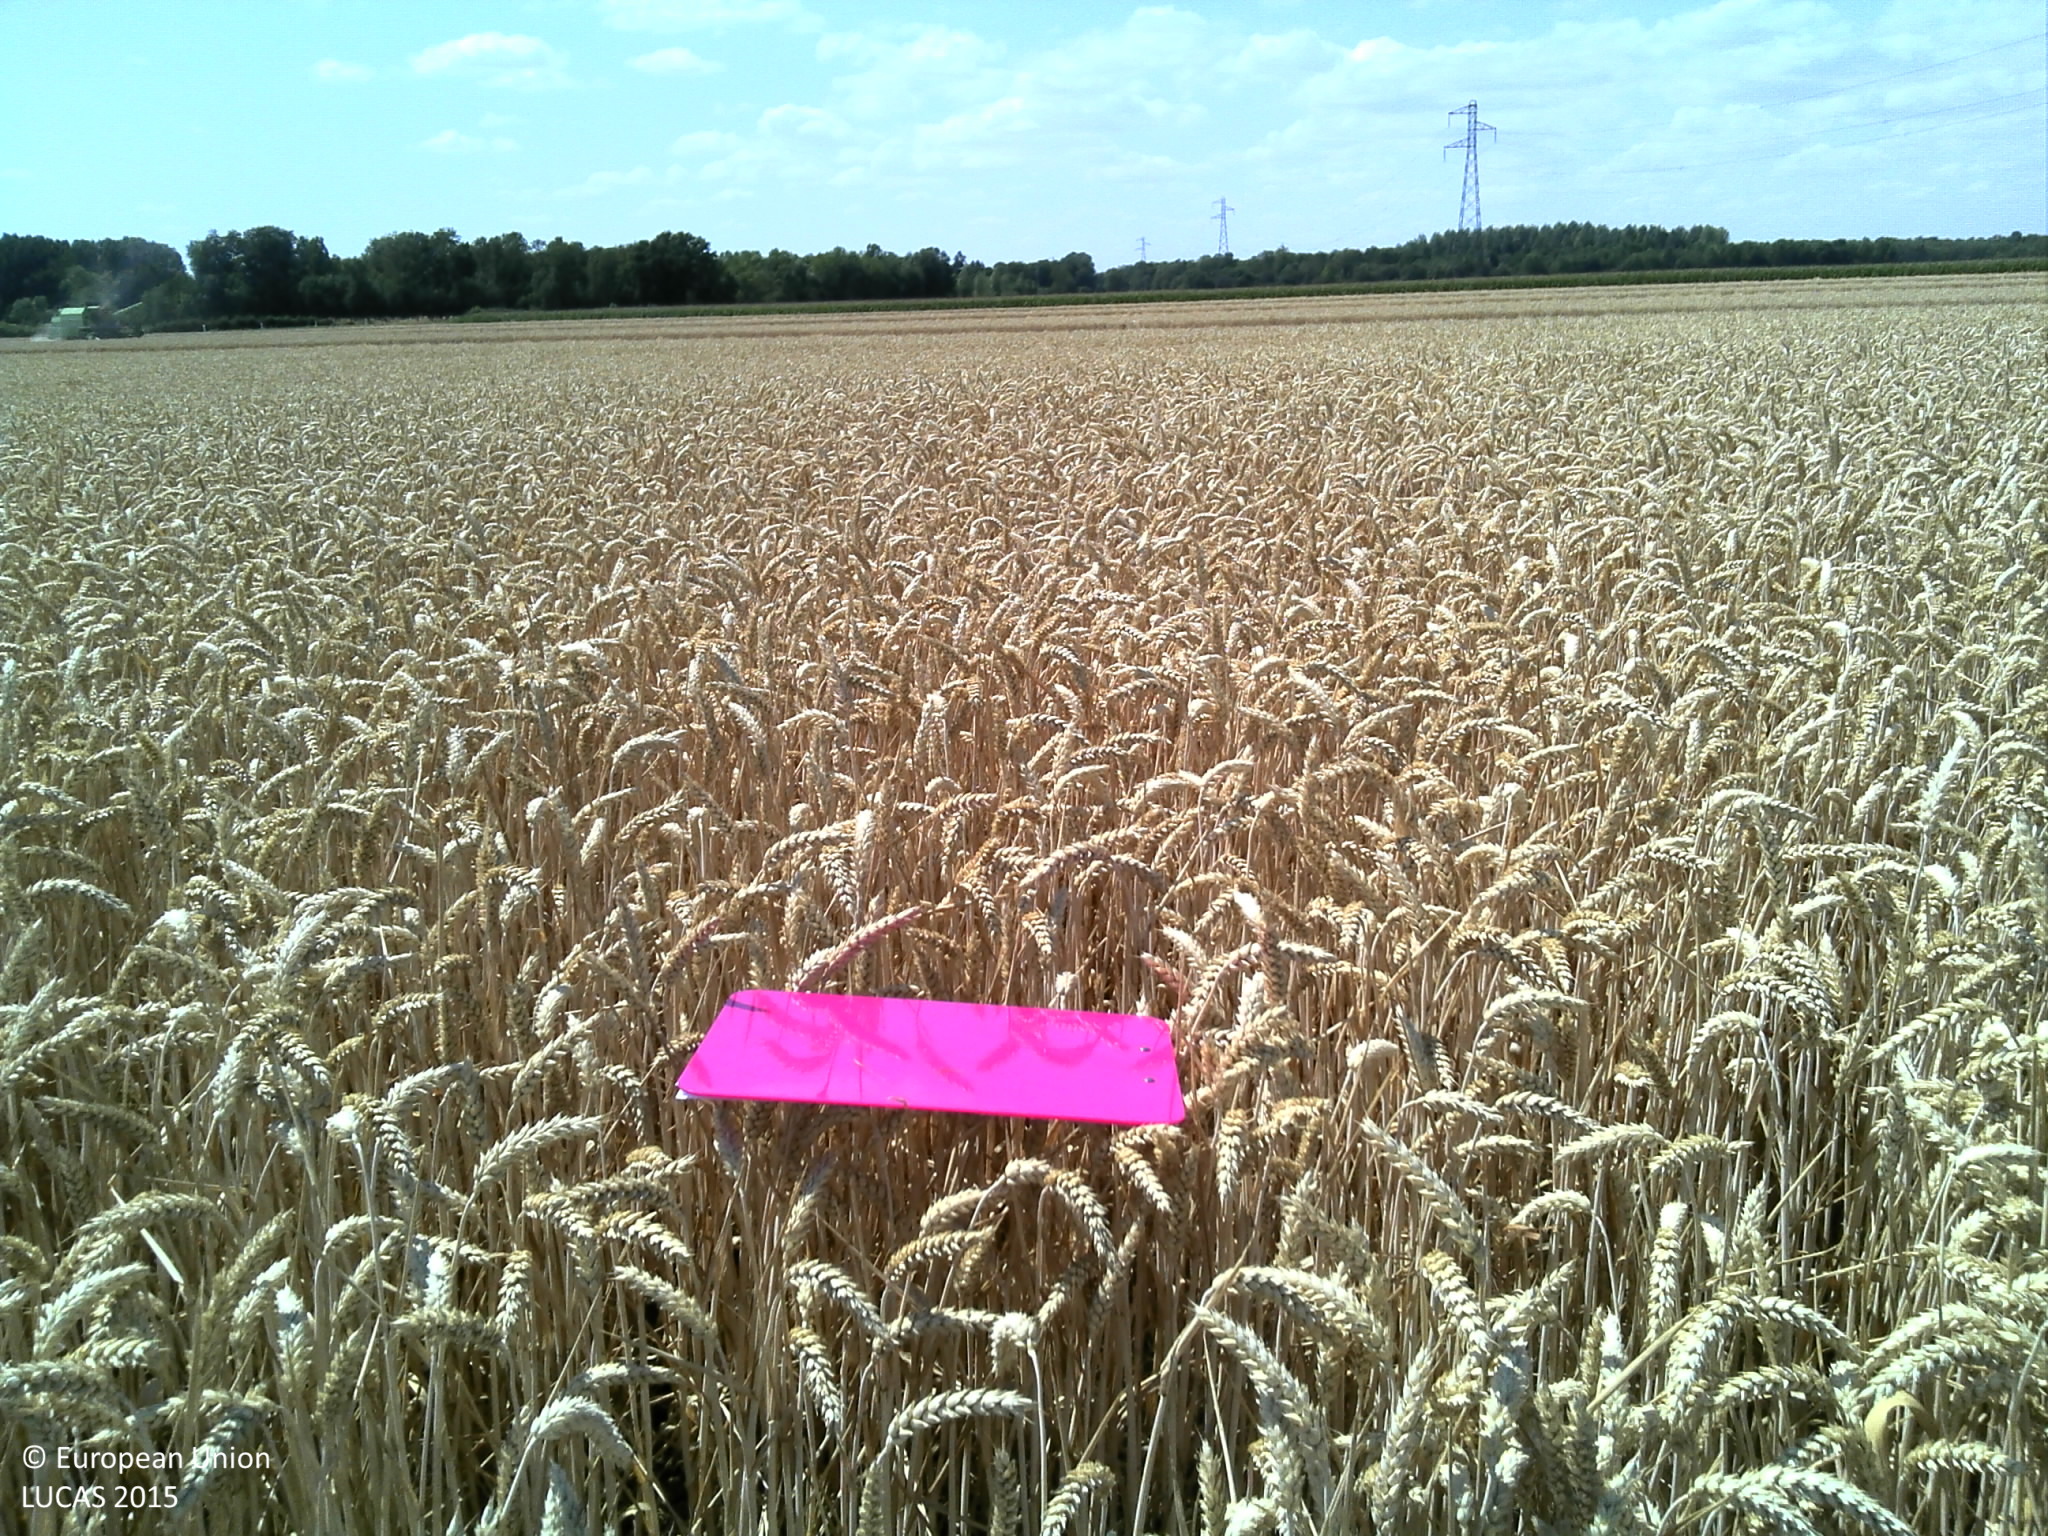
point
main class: Cropland
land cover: Common wheat
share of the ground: > 75 %
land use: Agriculture (excluding fallow land and kitchen gardens)
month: July
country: FR
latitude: 48.6225
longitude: 4.7747
